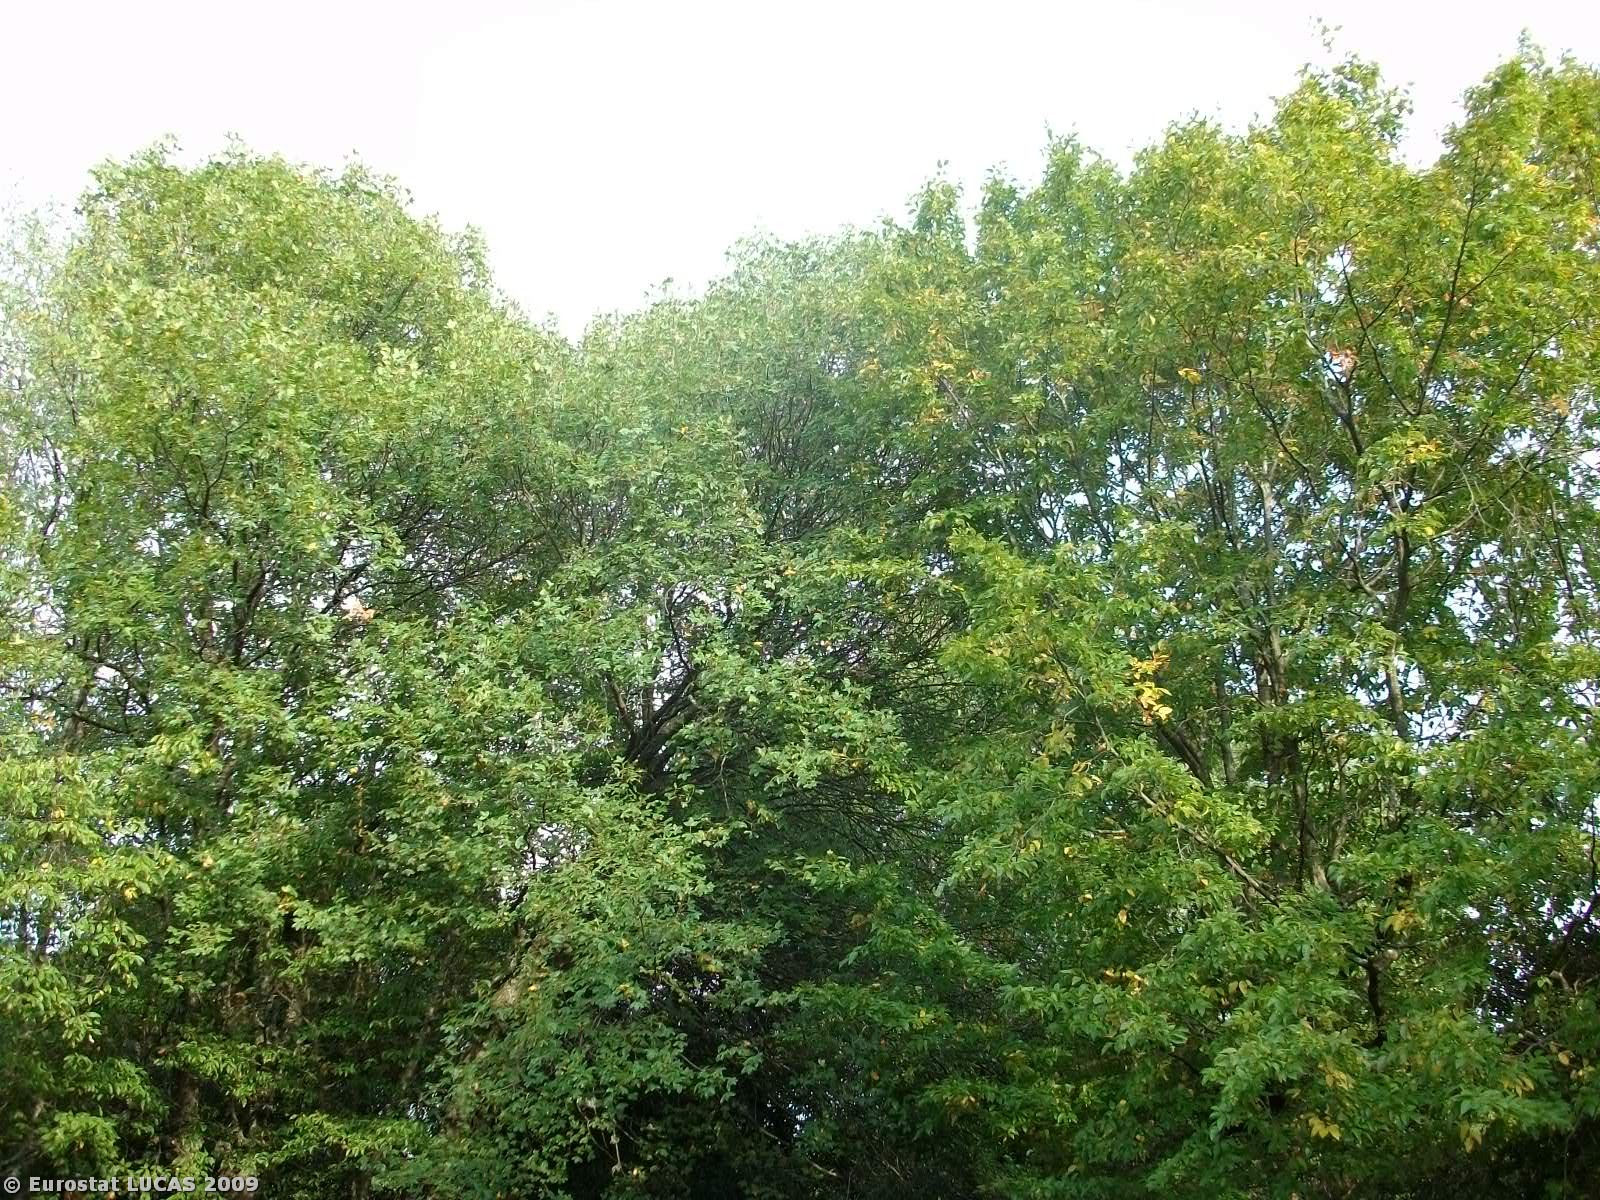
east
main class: Woodland
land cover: Broadleaved woodland
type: broadleaved evergreen forest
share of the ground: 50 - 75 %
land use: Forestry
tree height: > 5 m
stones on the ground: 25 - 50 %
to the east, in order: Broadleaved woodland; Rock outcrops; Grassland with sparse tree/shrub cover; Broadleaved woodland; Grassland without tree/shrub cover; Rock outcrops; Grassland without tree/shrub cover
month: September
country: GR
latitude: 41.1160
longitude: 24.4562
